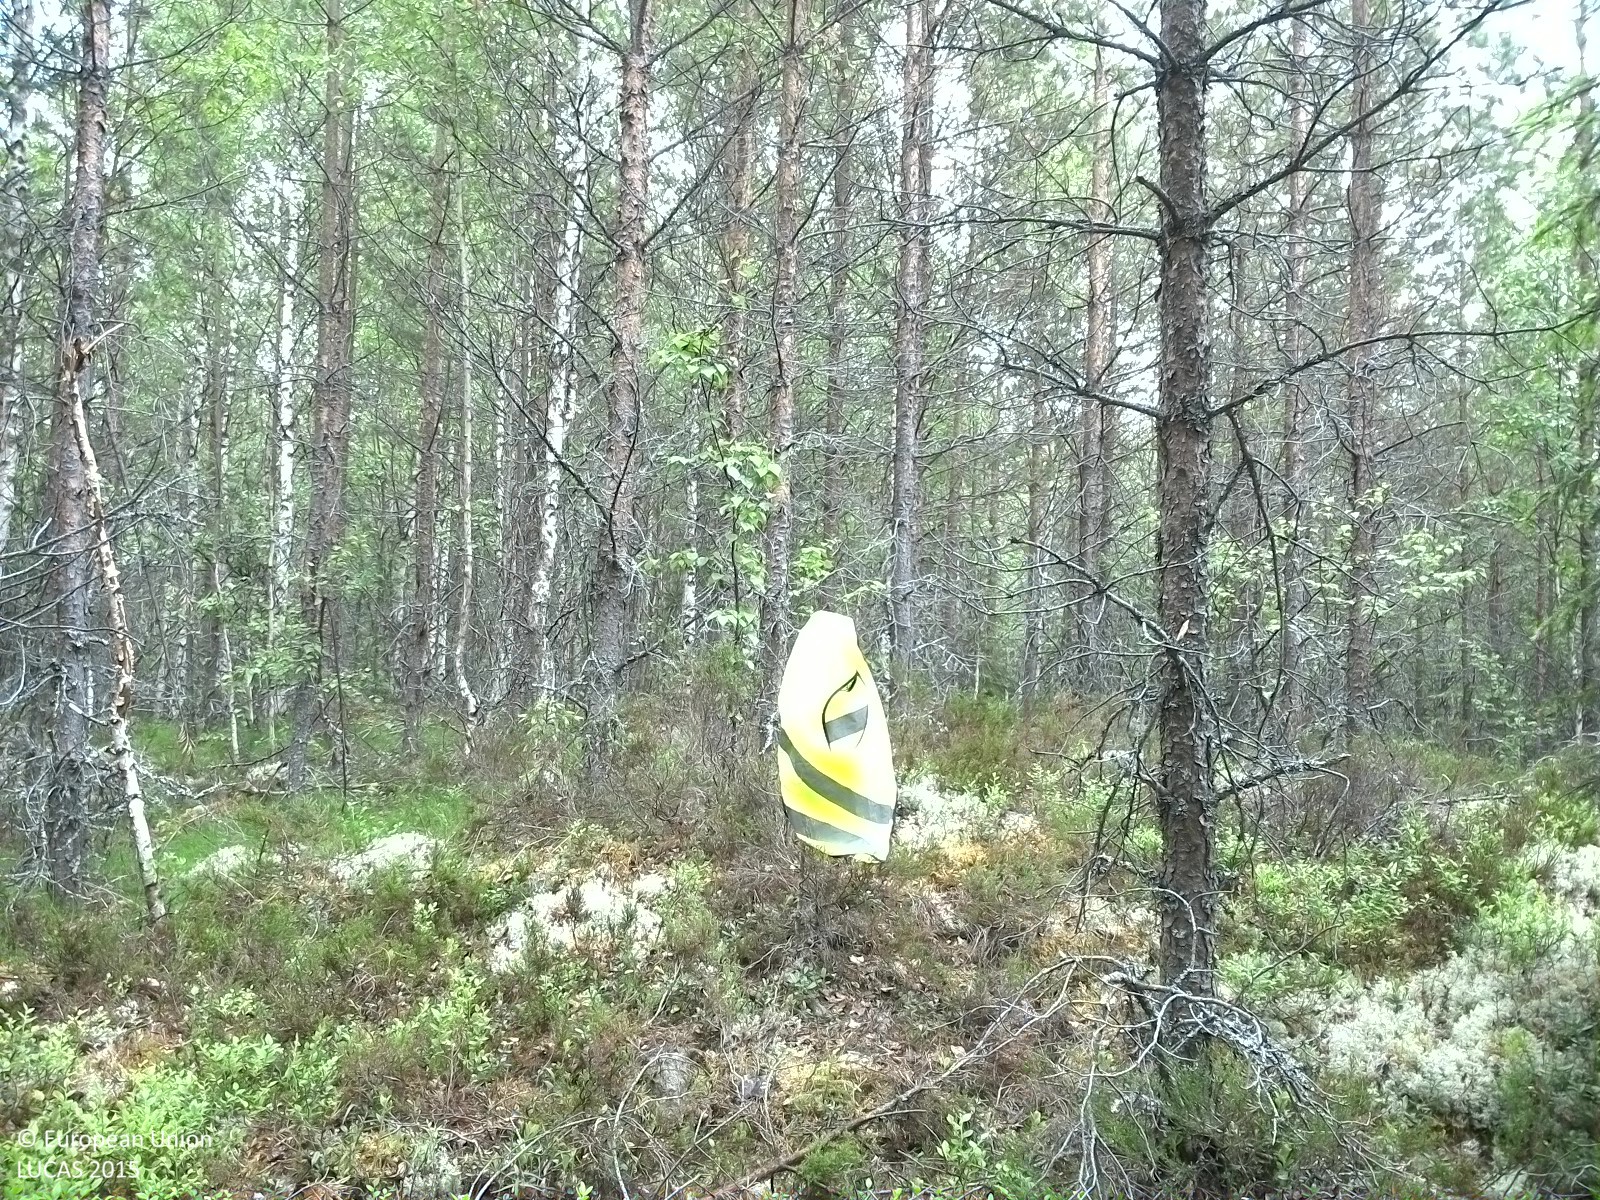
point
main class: Woodland
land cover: Pine dominated coniferous woodland
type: boreal forest
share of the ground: 50 - 75 %
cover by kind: coniferous forest trees 50 %, shrubs 30 %, broadleaved forest trees 10 %, lichens and mosses 10 %
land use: Forestry
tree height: > 5 m
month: June
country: SE
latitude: 62.1420
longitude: 16.1771
